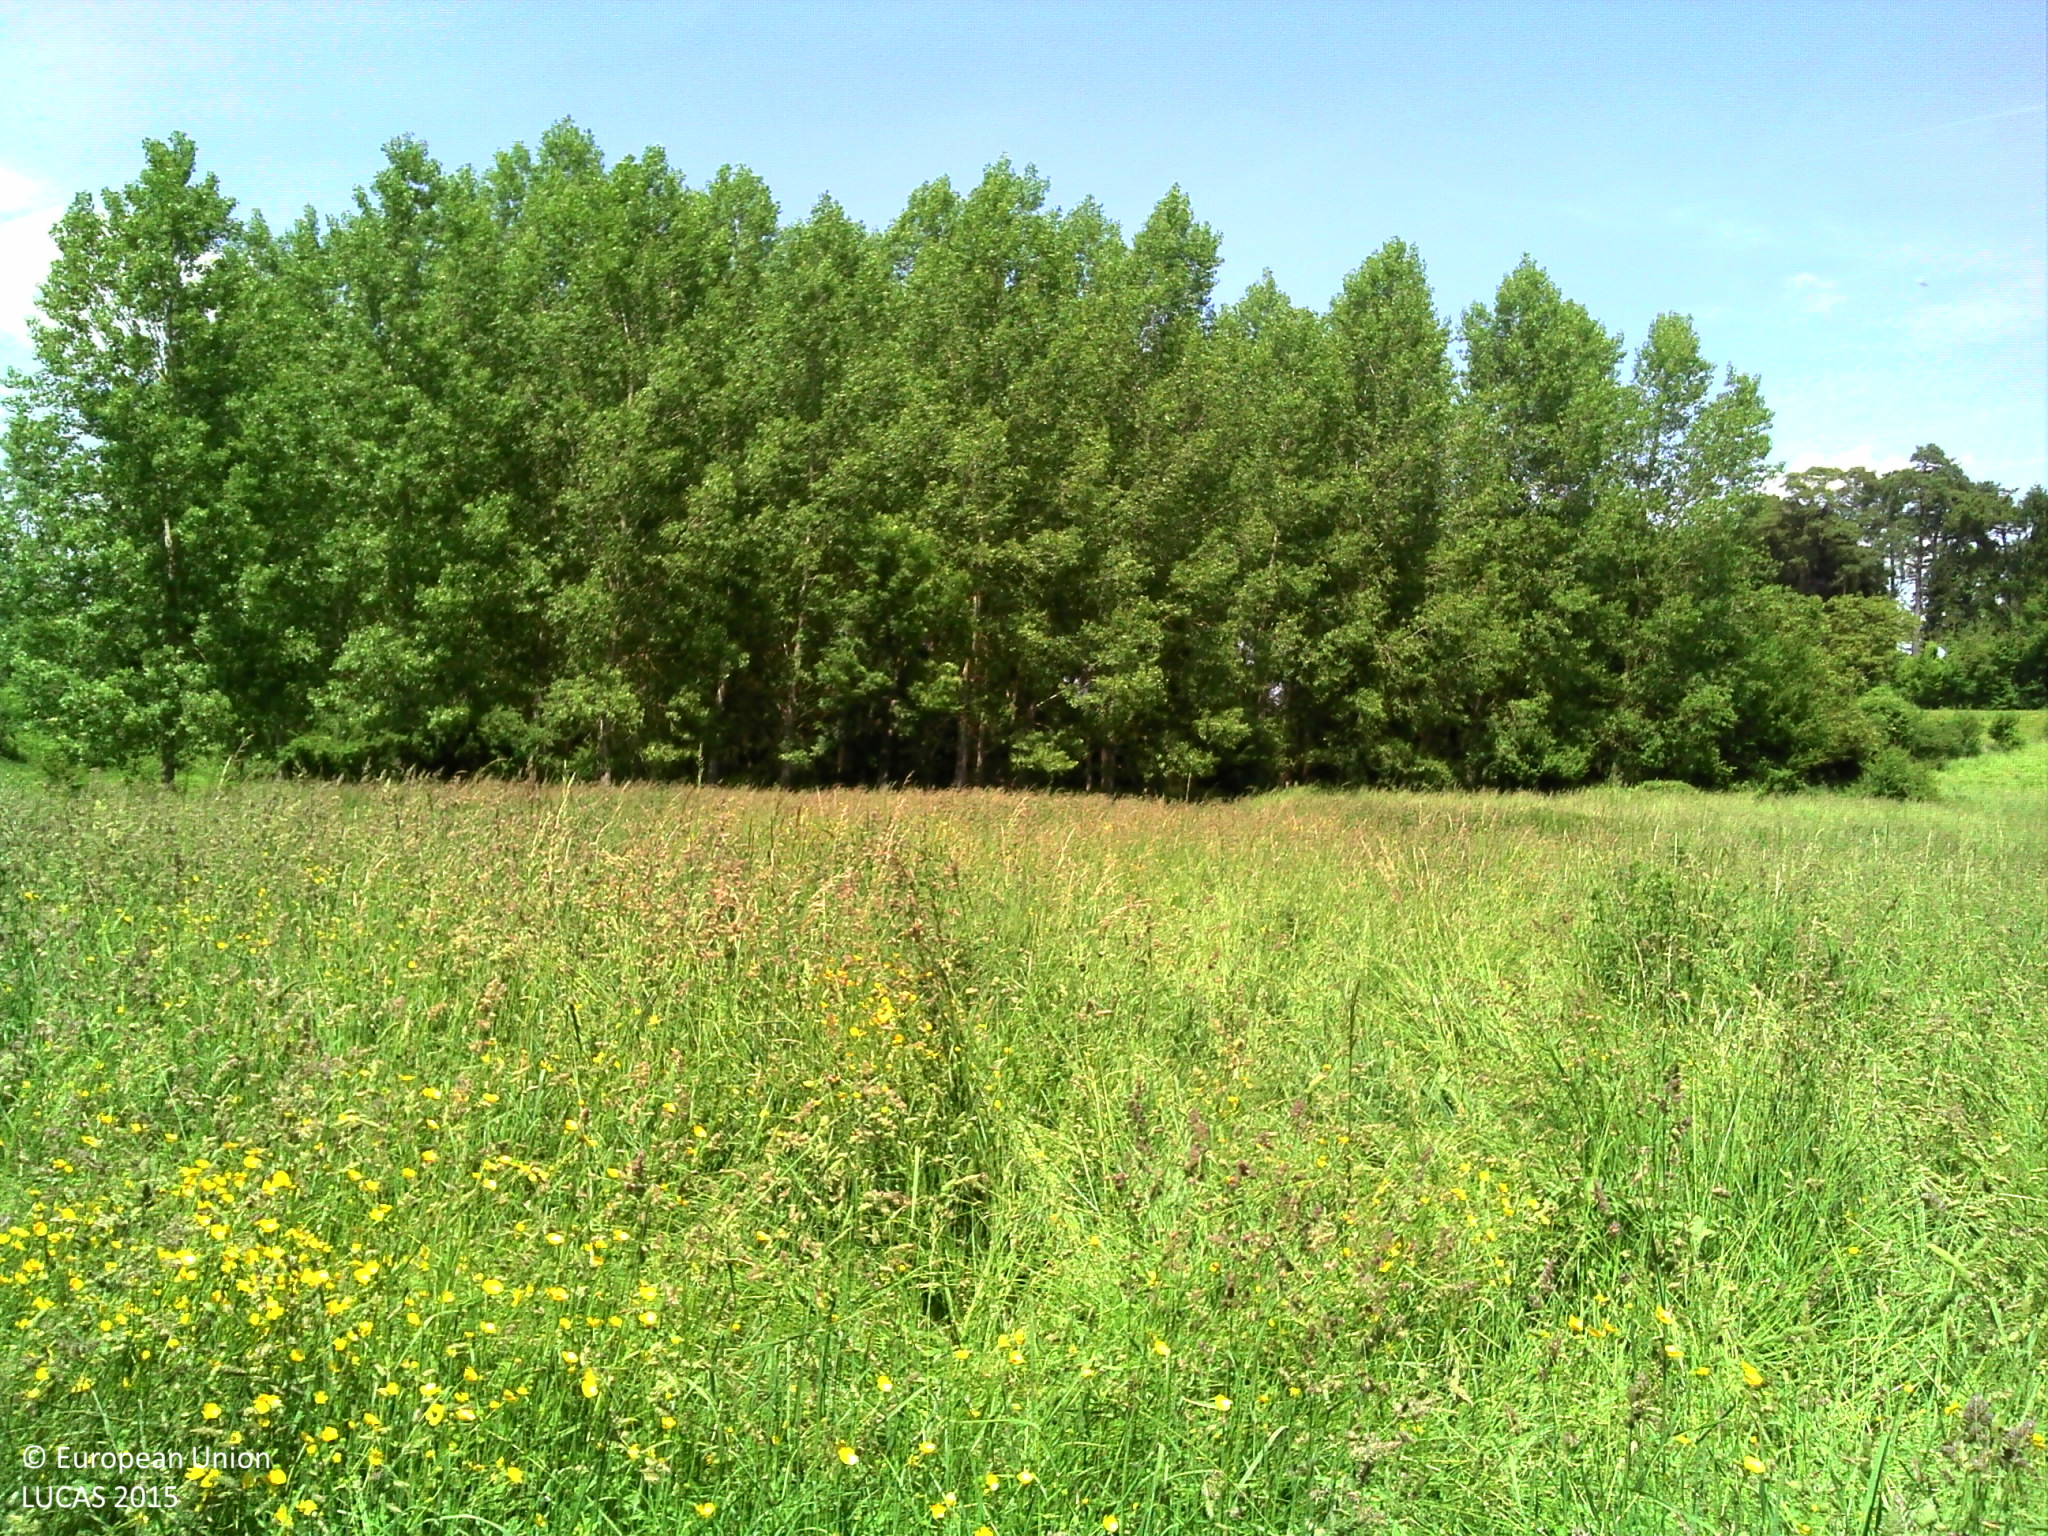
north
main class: Grassland
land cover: Grassland without tree/shrub cover
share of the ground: > 75 %
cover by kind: herbaceous plants 100 %
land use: Agriculture (excluding fallow land and kitchen gardens)
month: May
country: FR
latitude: 47.2716
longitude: 2.8963
